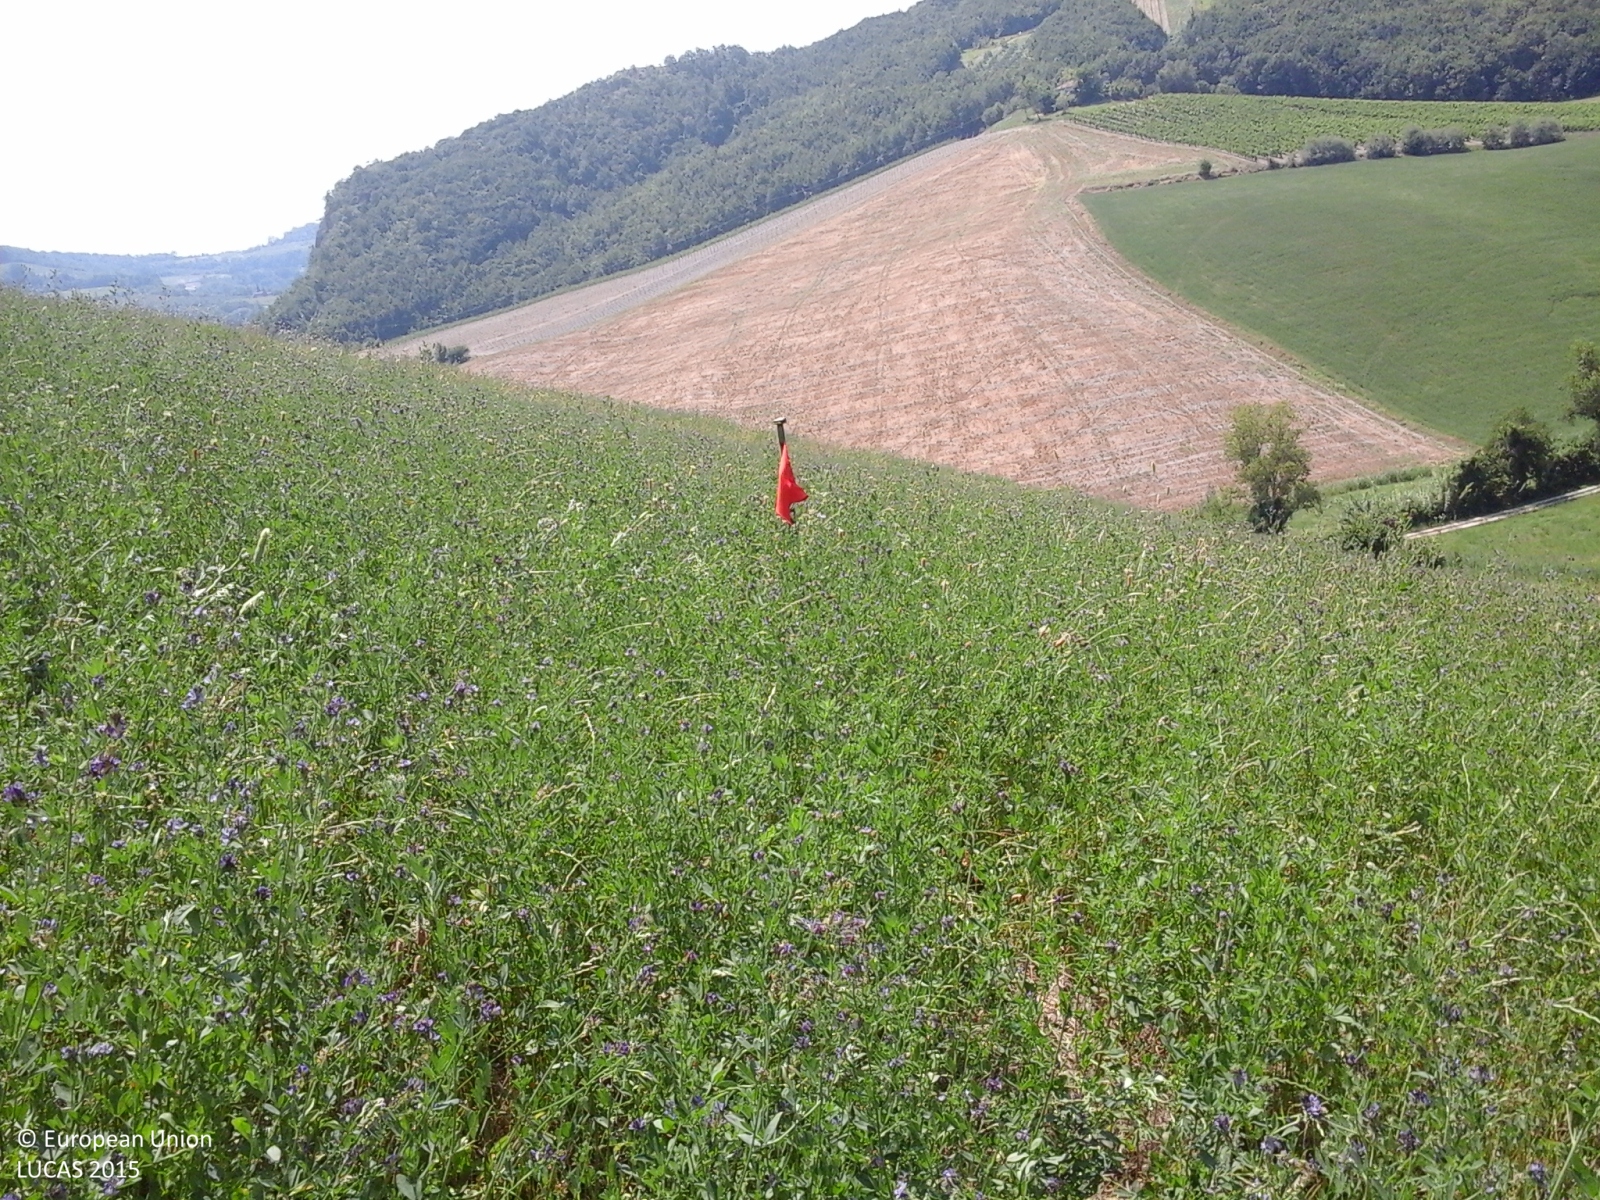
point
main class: Cropland
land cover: Lucerne
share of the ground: > 75 %
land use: Agriculture (excluding fallow land and kitchen gardens)
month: July
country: IT
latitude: 44.2462
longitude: 11.7117
